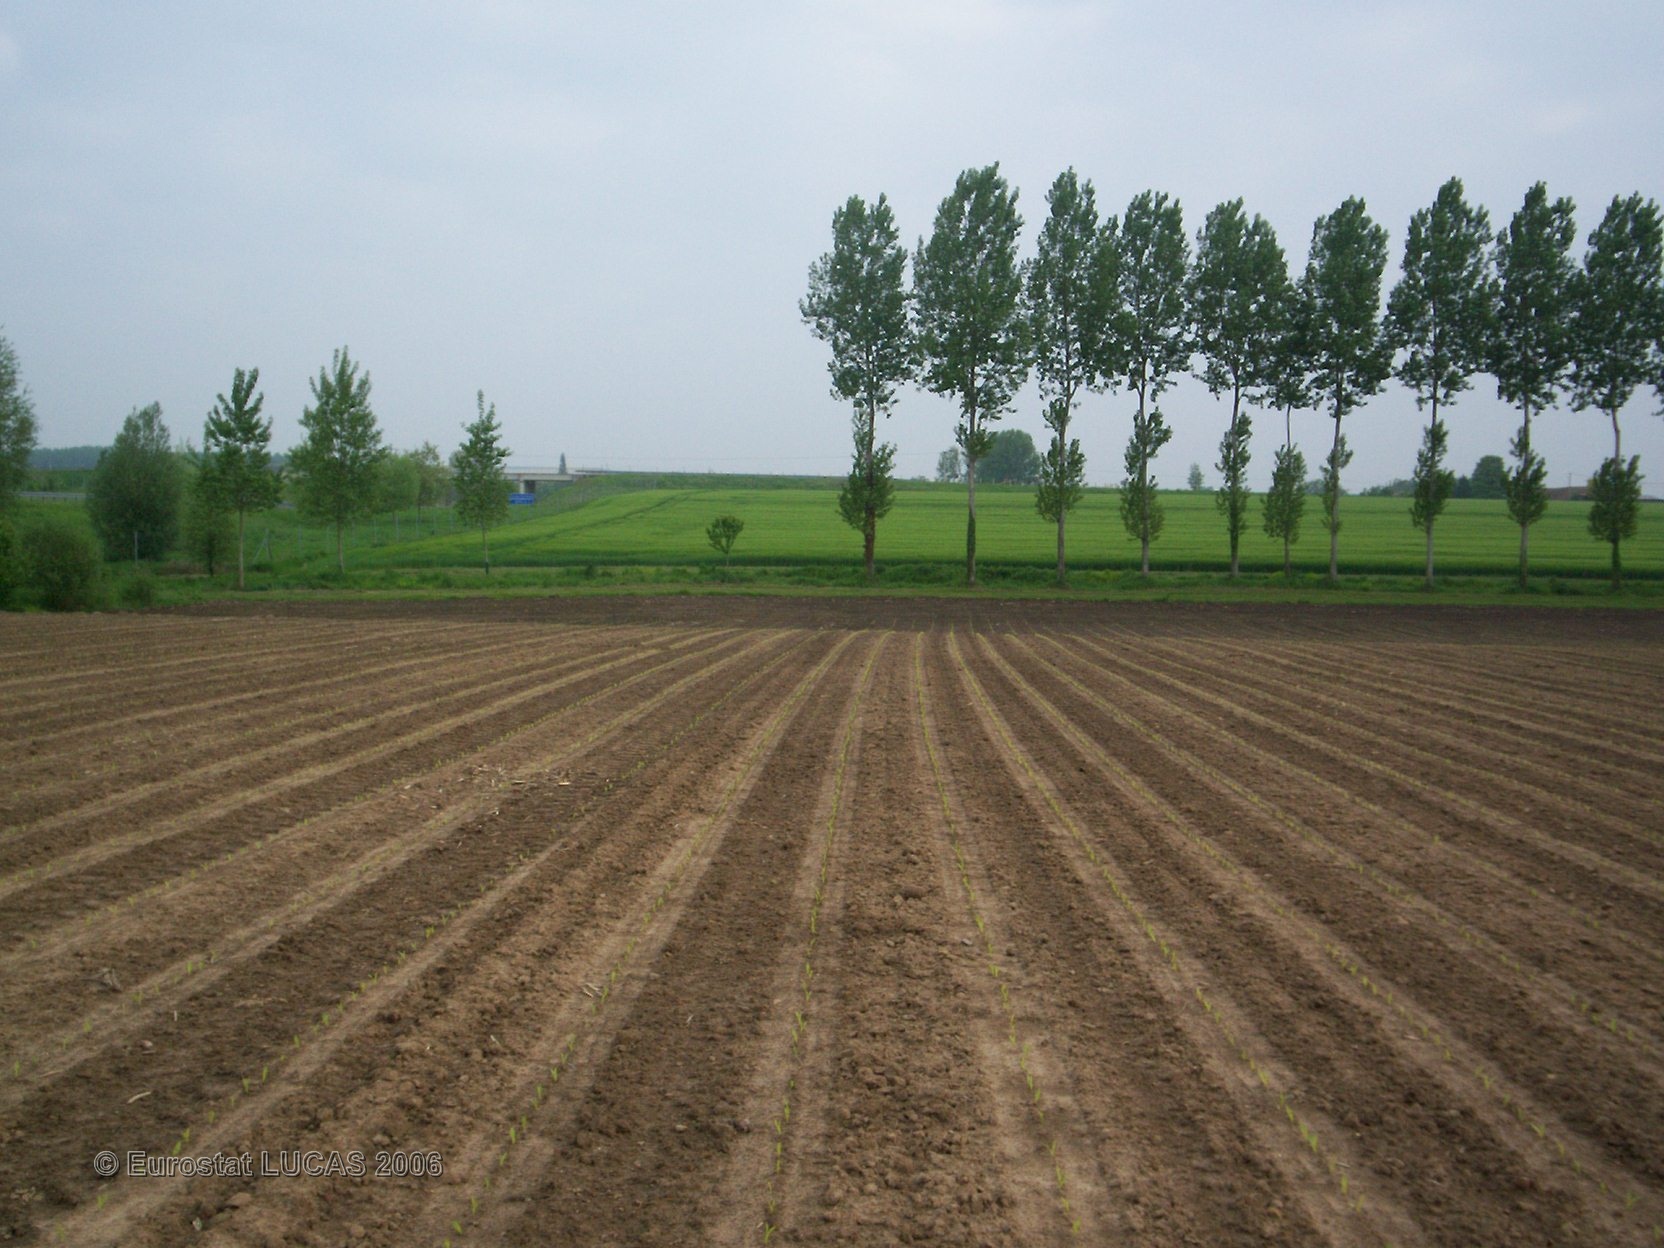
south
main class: Cropland
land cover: Maize
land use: Agriculture (excluding fallow land and kitchen gardens)
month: May
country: FR
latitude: 47.9039
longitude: 0.3031
